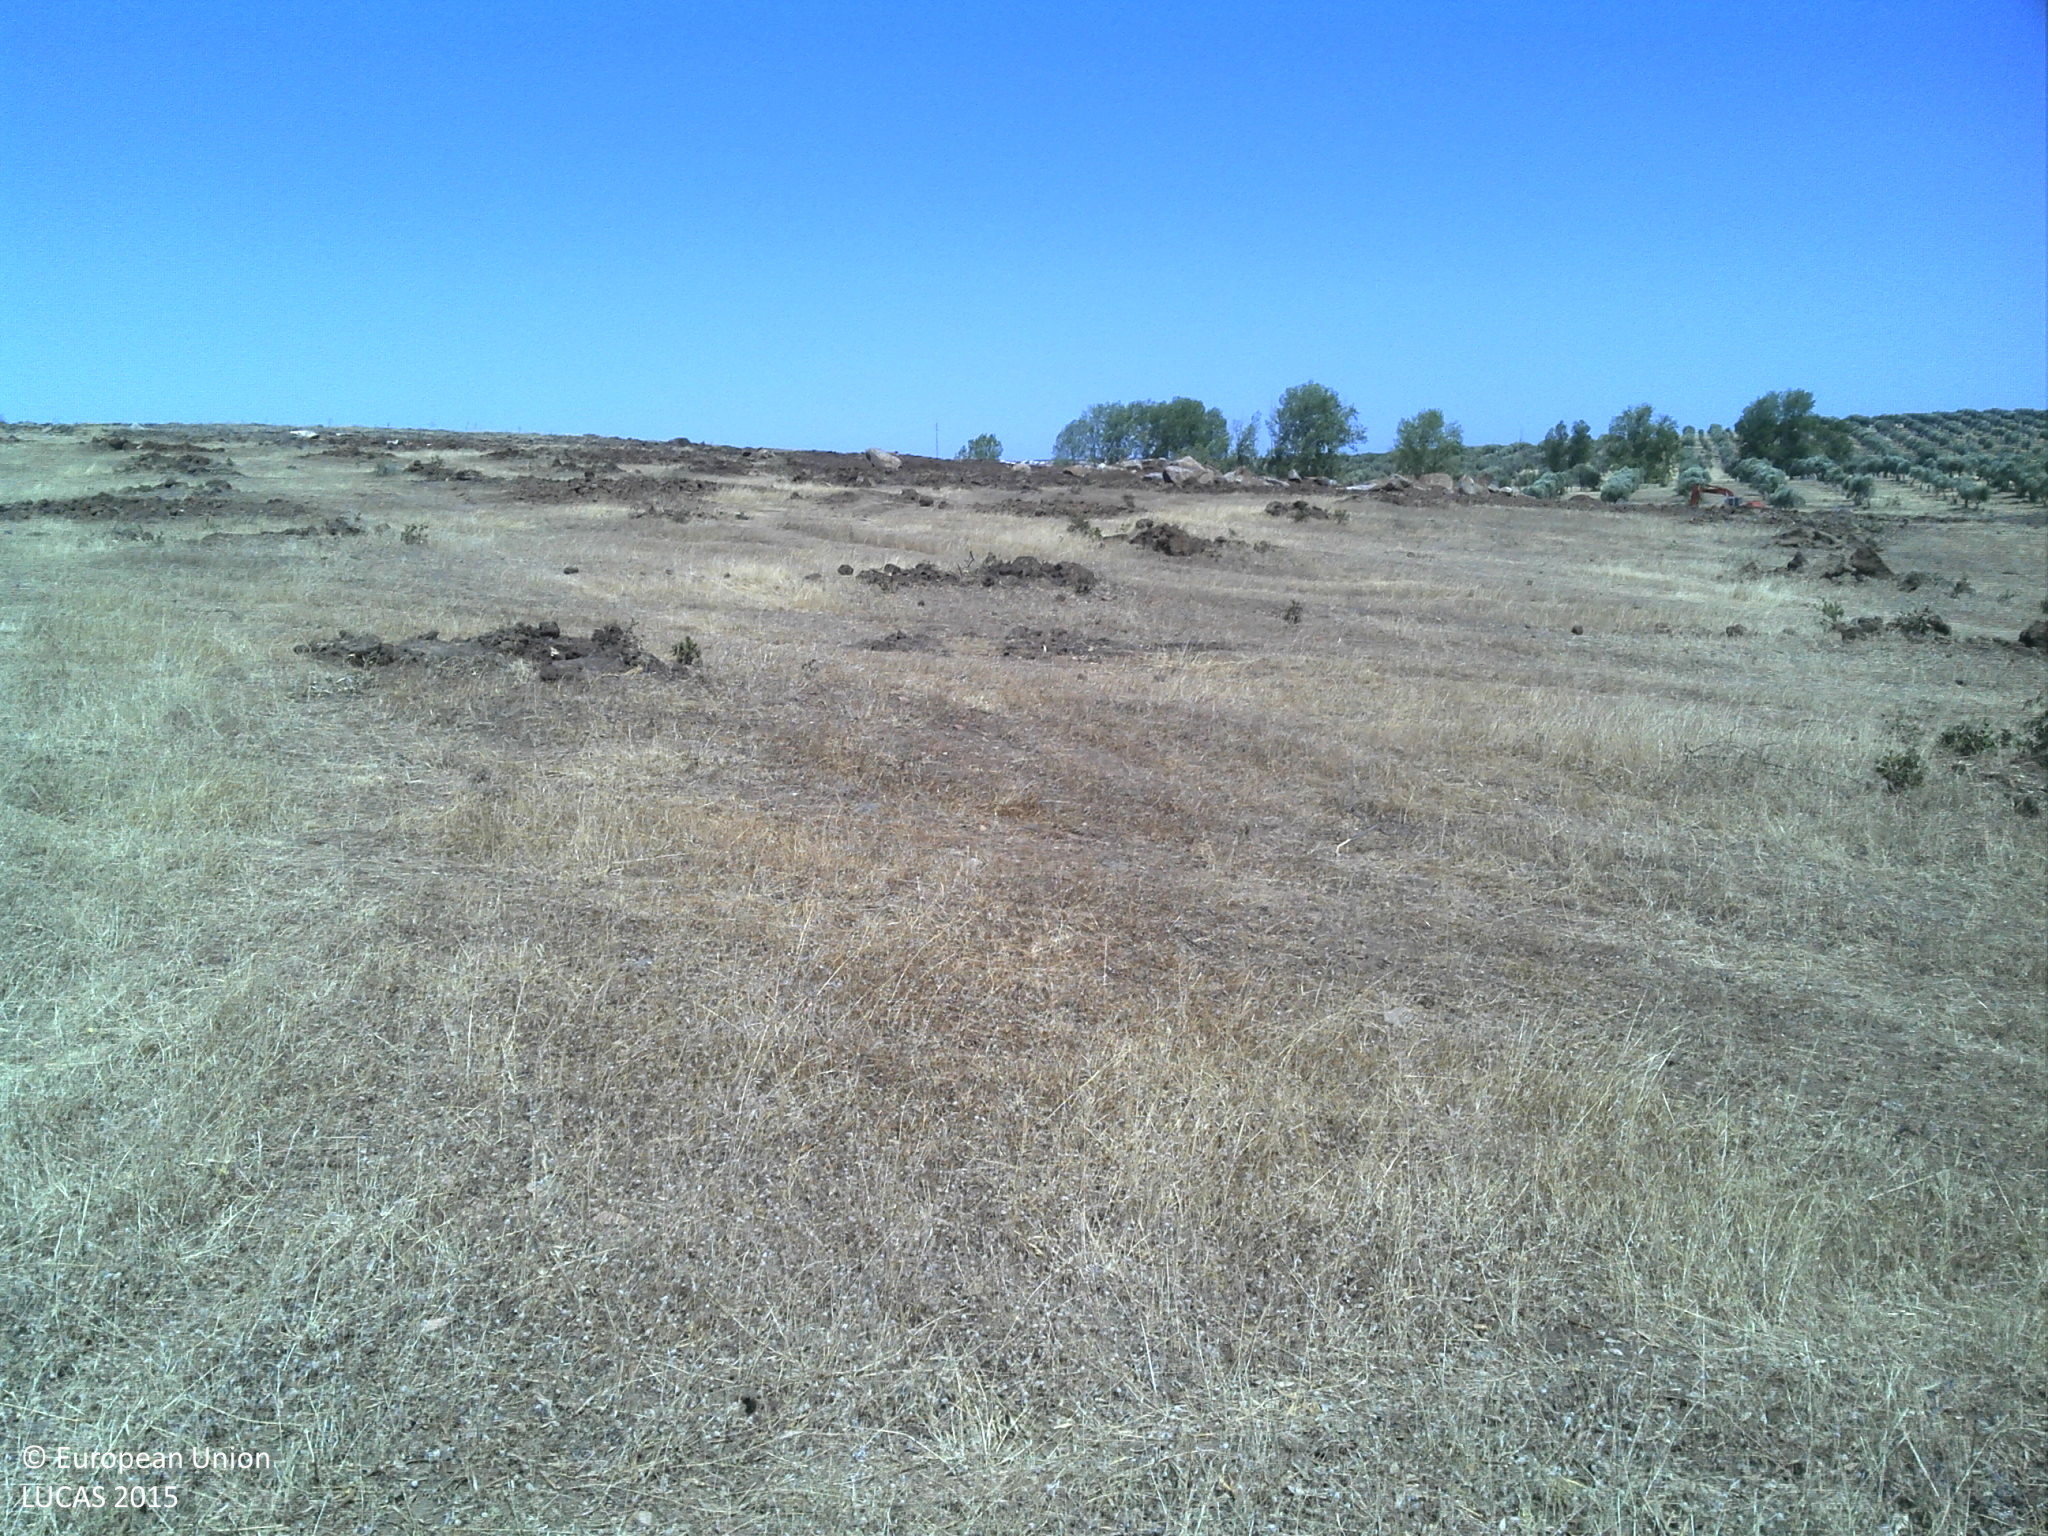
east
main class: Grassland
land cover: Grassland without tree/shrub cover
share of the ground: 10 - 25 %
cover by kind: unconsolidated bare surface 75 %, herbaceous plants 25 %
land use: Agriculture (excluding fallow land and kitchen gardens)
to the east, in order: Grassland without tree/shrub cover; Other bare soil
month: July
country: PT
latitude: 38.0811
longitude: -8.0345
